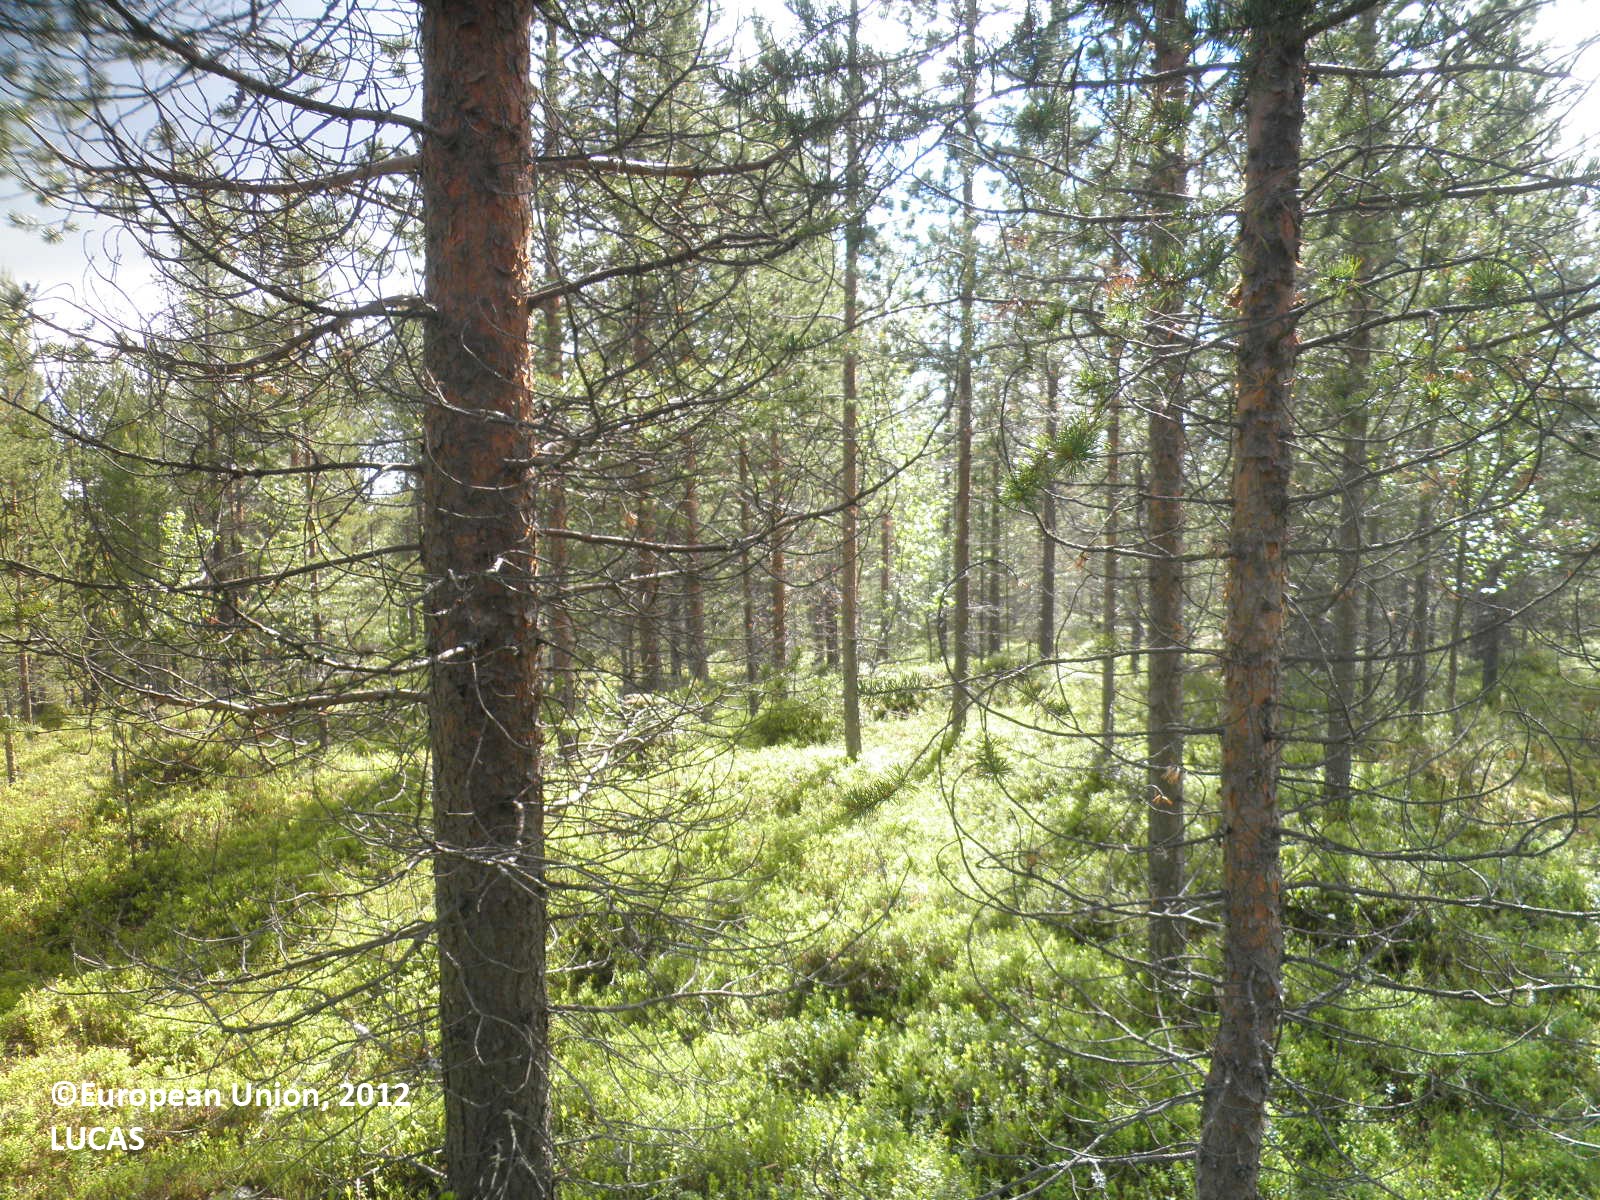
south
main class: Woodland
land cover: Pine dominated coniferous woodland
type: boreal forest
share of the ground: 50 - 75 %
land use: Forestry
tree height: > 5 m
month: July
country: FI
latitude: 68.7580
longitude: 28.0208
